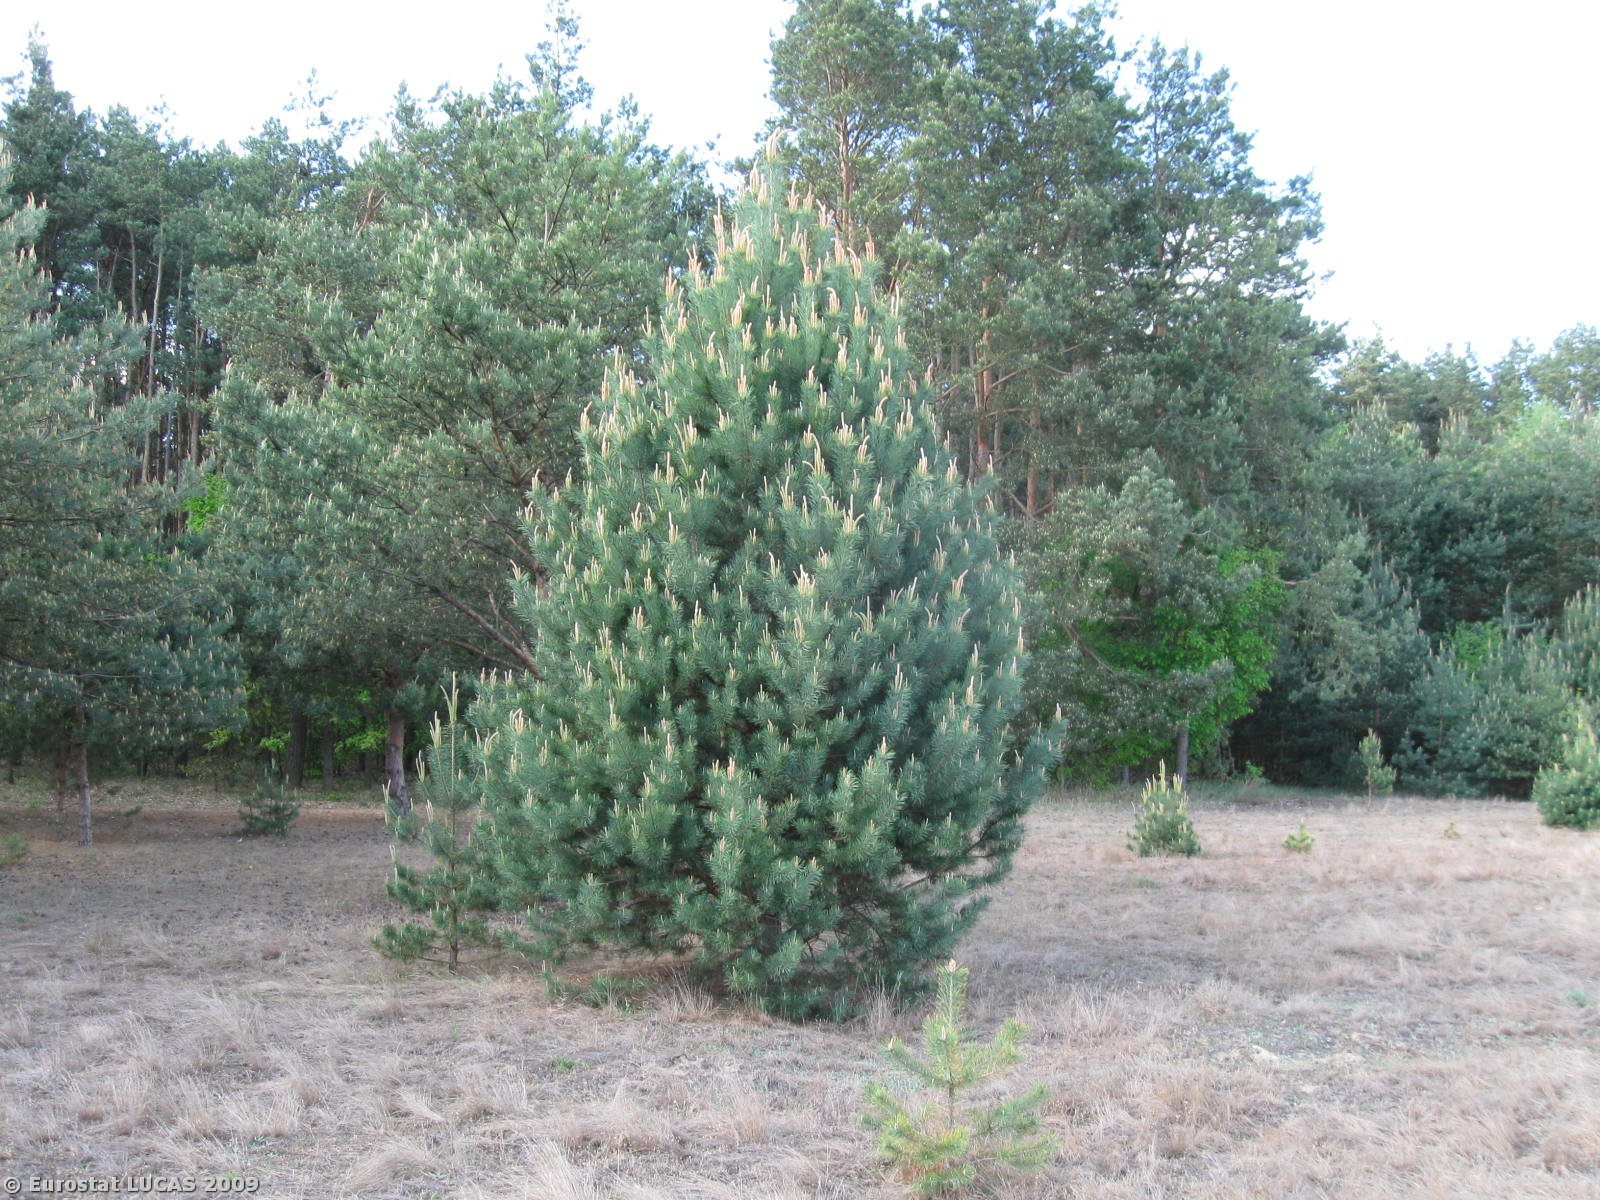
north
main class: Grassland
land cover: Grassland with sparse tree/shrub cover
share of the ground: > 75 %
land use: Unused
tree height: < 5 m
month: May
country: PL
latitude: 51.3220
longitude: 19.9768
